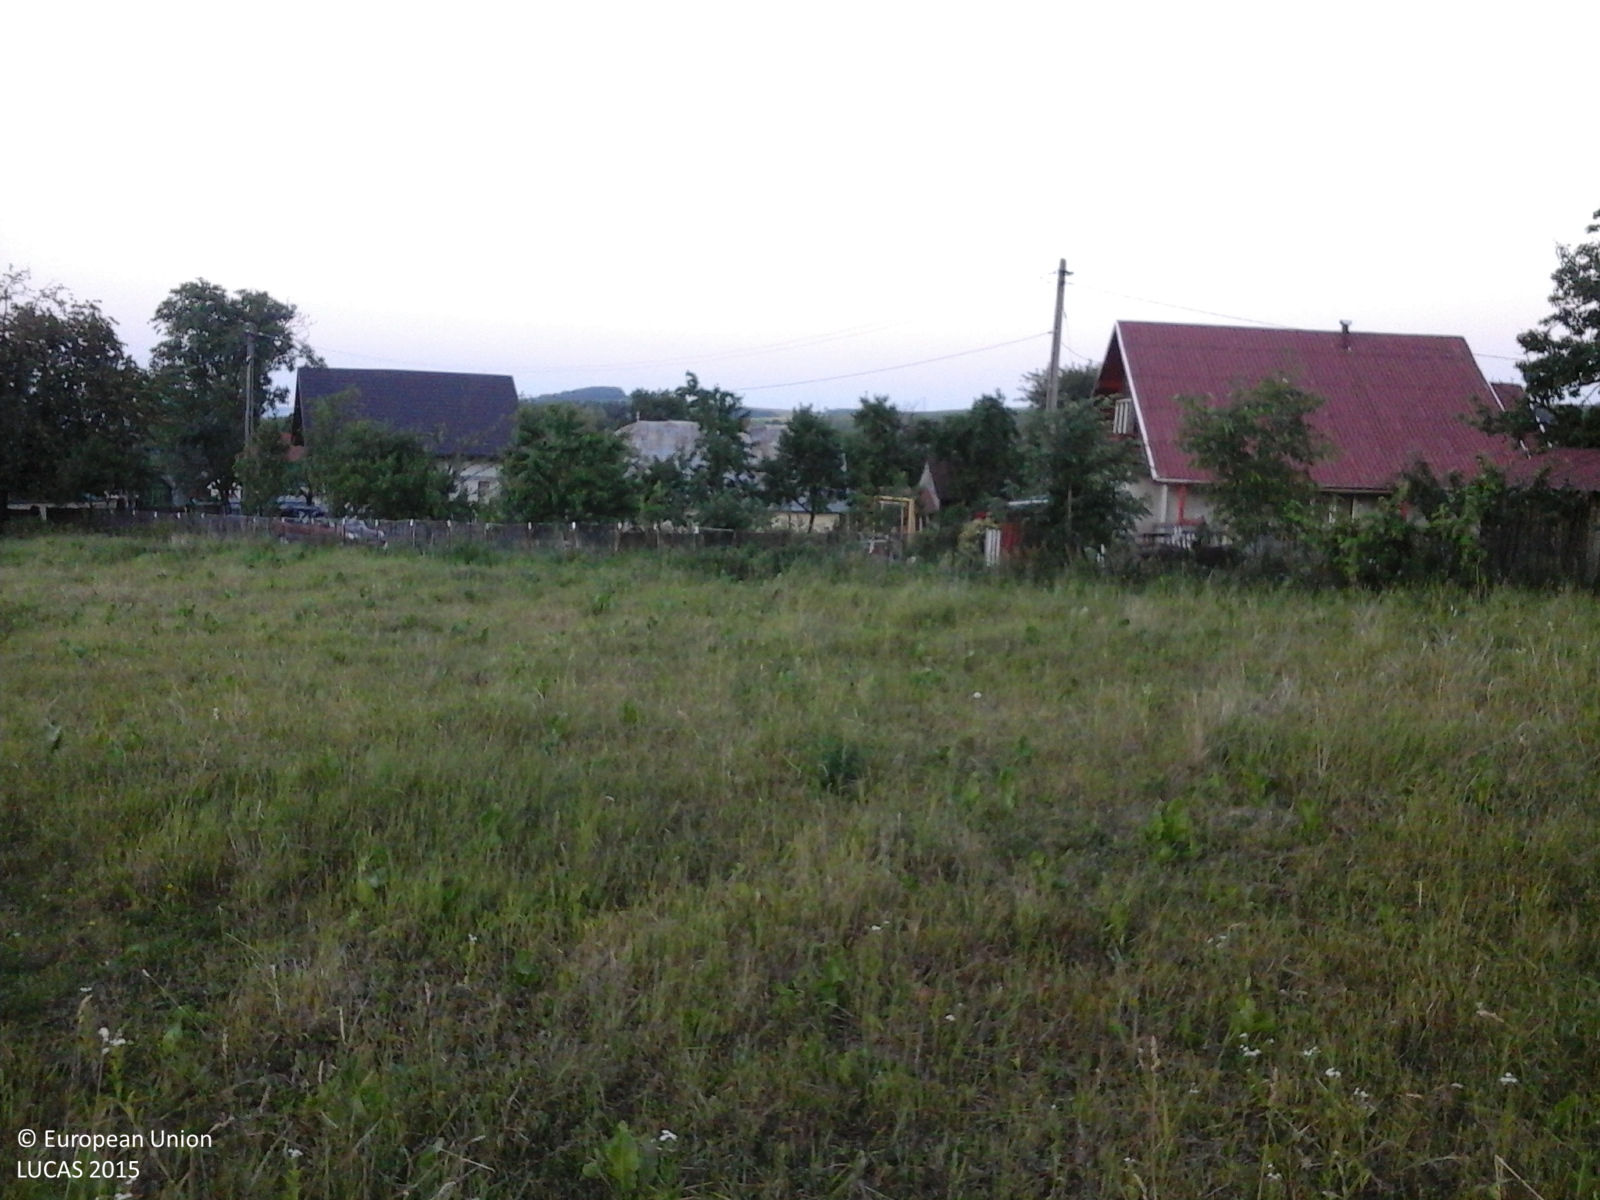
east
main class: Cropland
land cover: Apple fruit
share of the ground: > 75 %
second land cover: Grassland without tree/shrub cover
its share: > 75 %
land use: Kitchen garden
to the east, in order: Apple fruit; Grassland without tree/shrub cover; Artificial constructions in urban areas; Arable land (only in case pi); Potatoes; Dry pulses; Other fresh vegetables; Grassland without tree/shrub cover
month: June
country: RO
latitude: 47.7358
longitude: 26.2864
